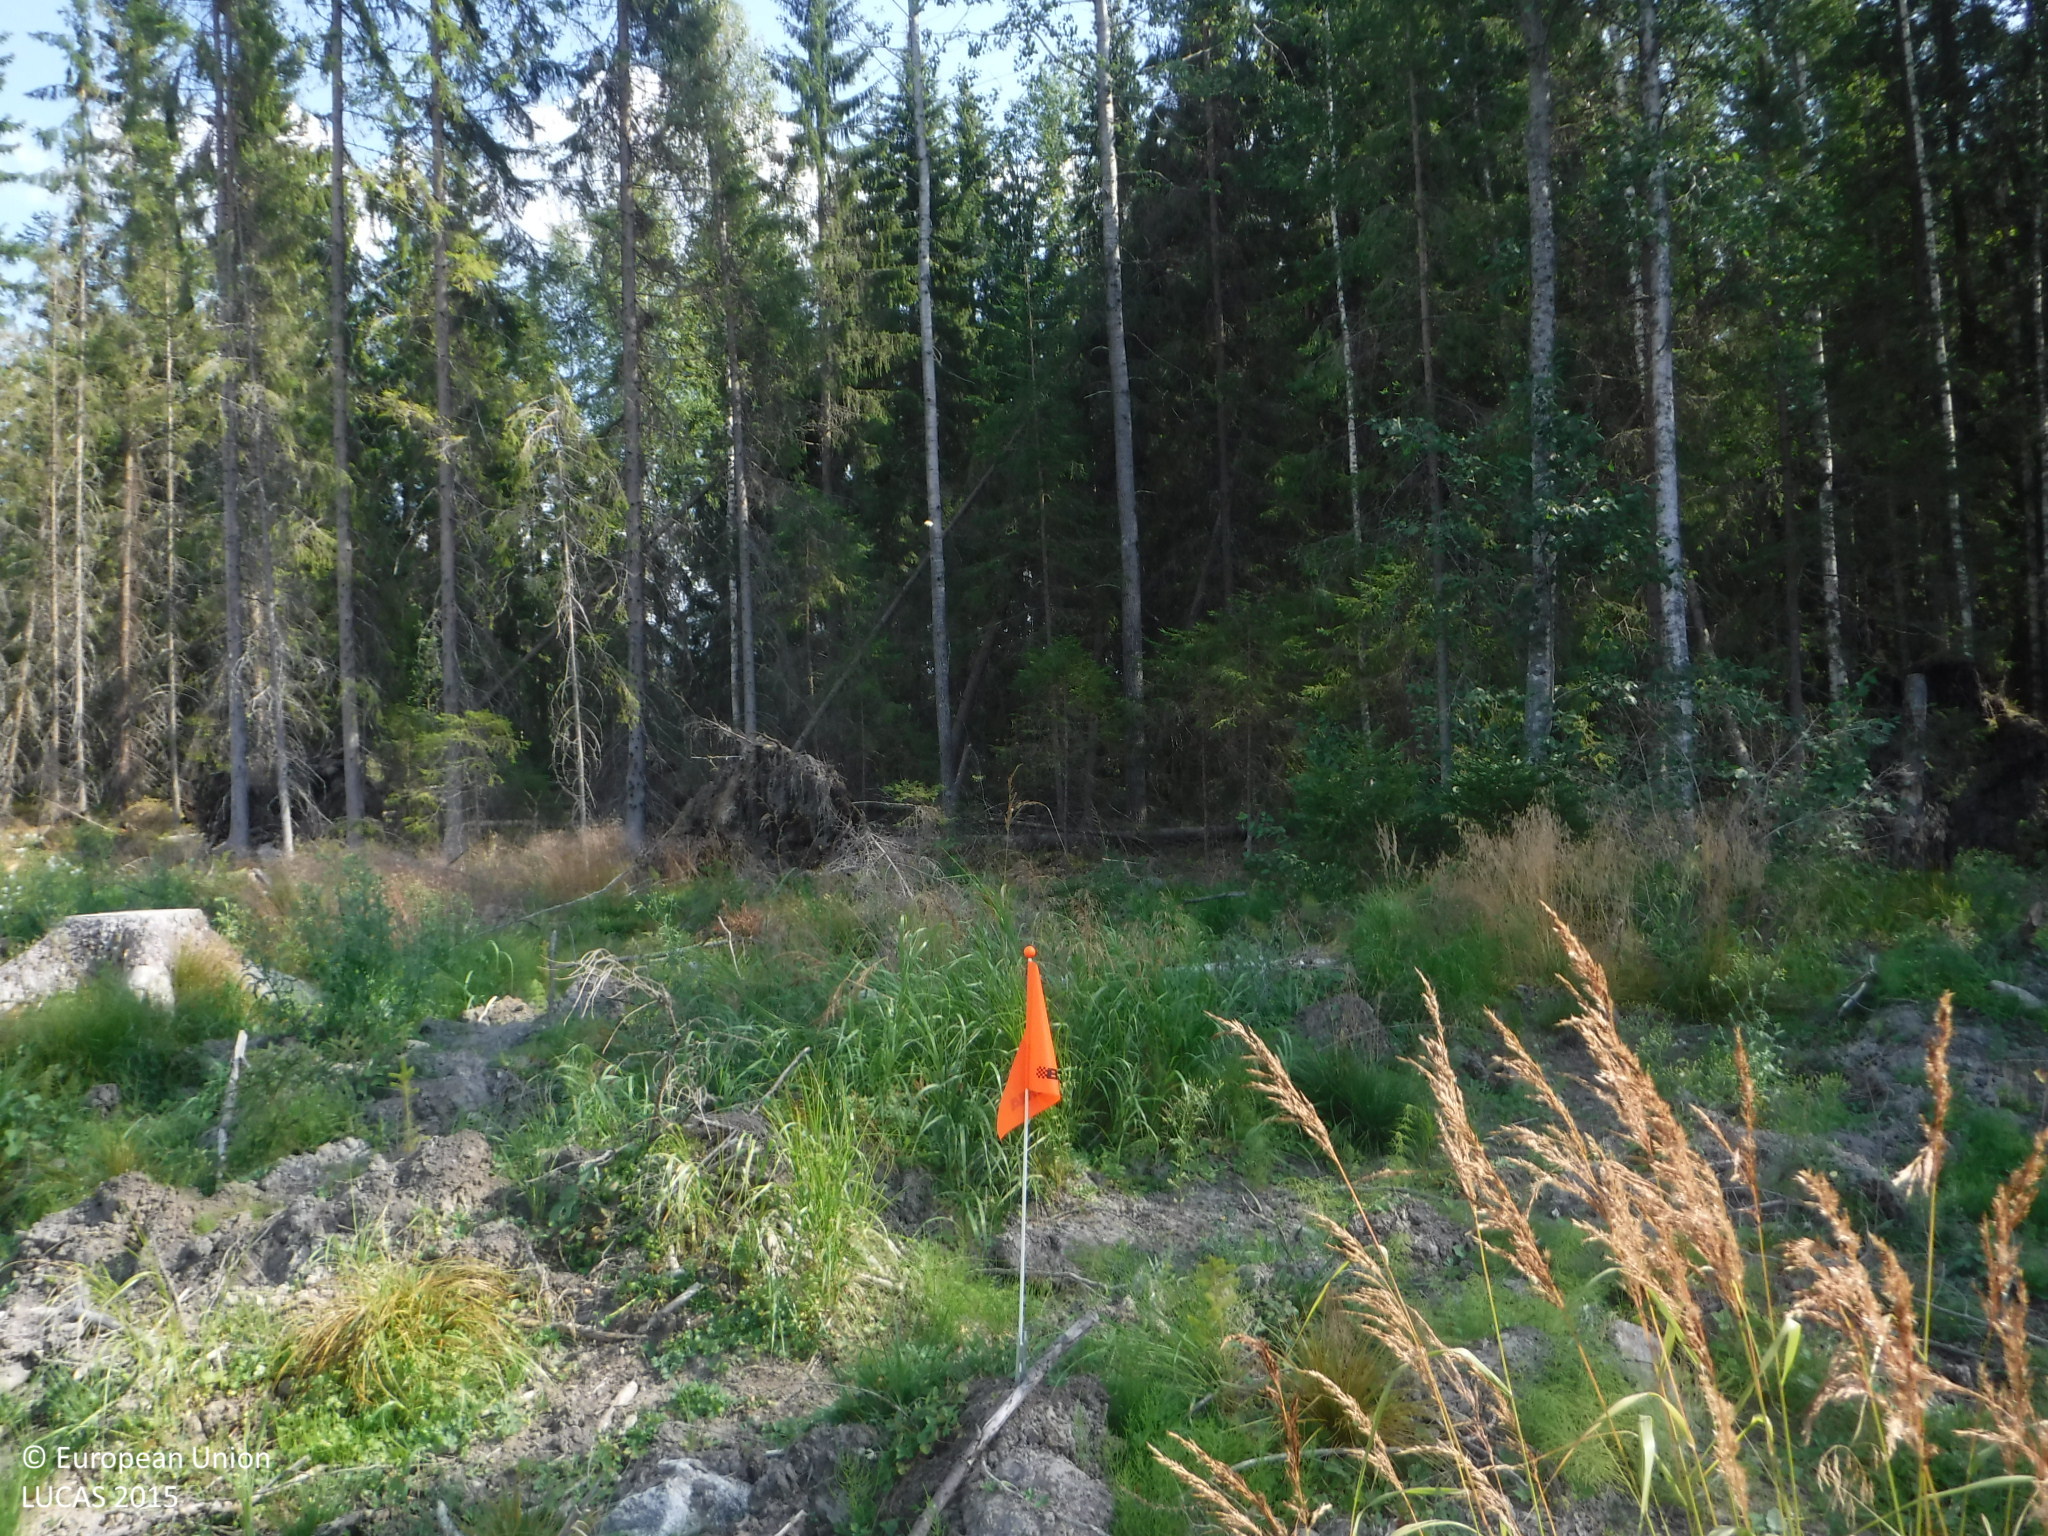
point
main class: Grassland
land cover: Spontaneously vegetated surfaces
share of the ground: 50 - 75 %
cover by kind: herbaceous plants 50 %, unconsolidated bare surface 35 %, shrubs 5 %
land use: Forestry
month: August
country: FI
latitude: 61.2039
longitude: 23.1966
